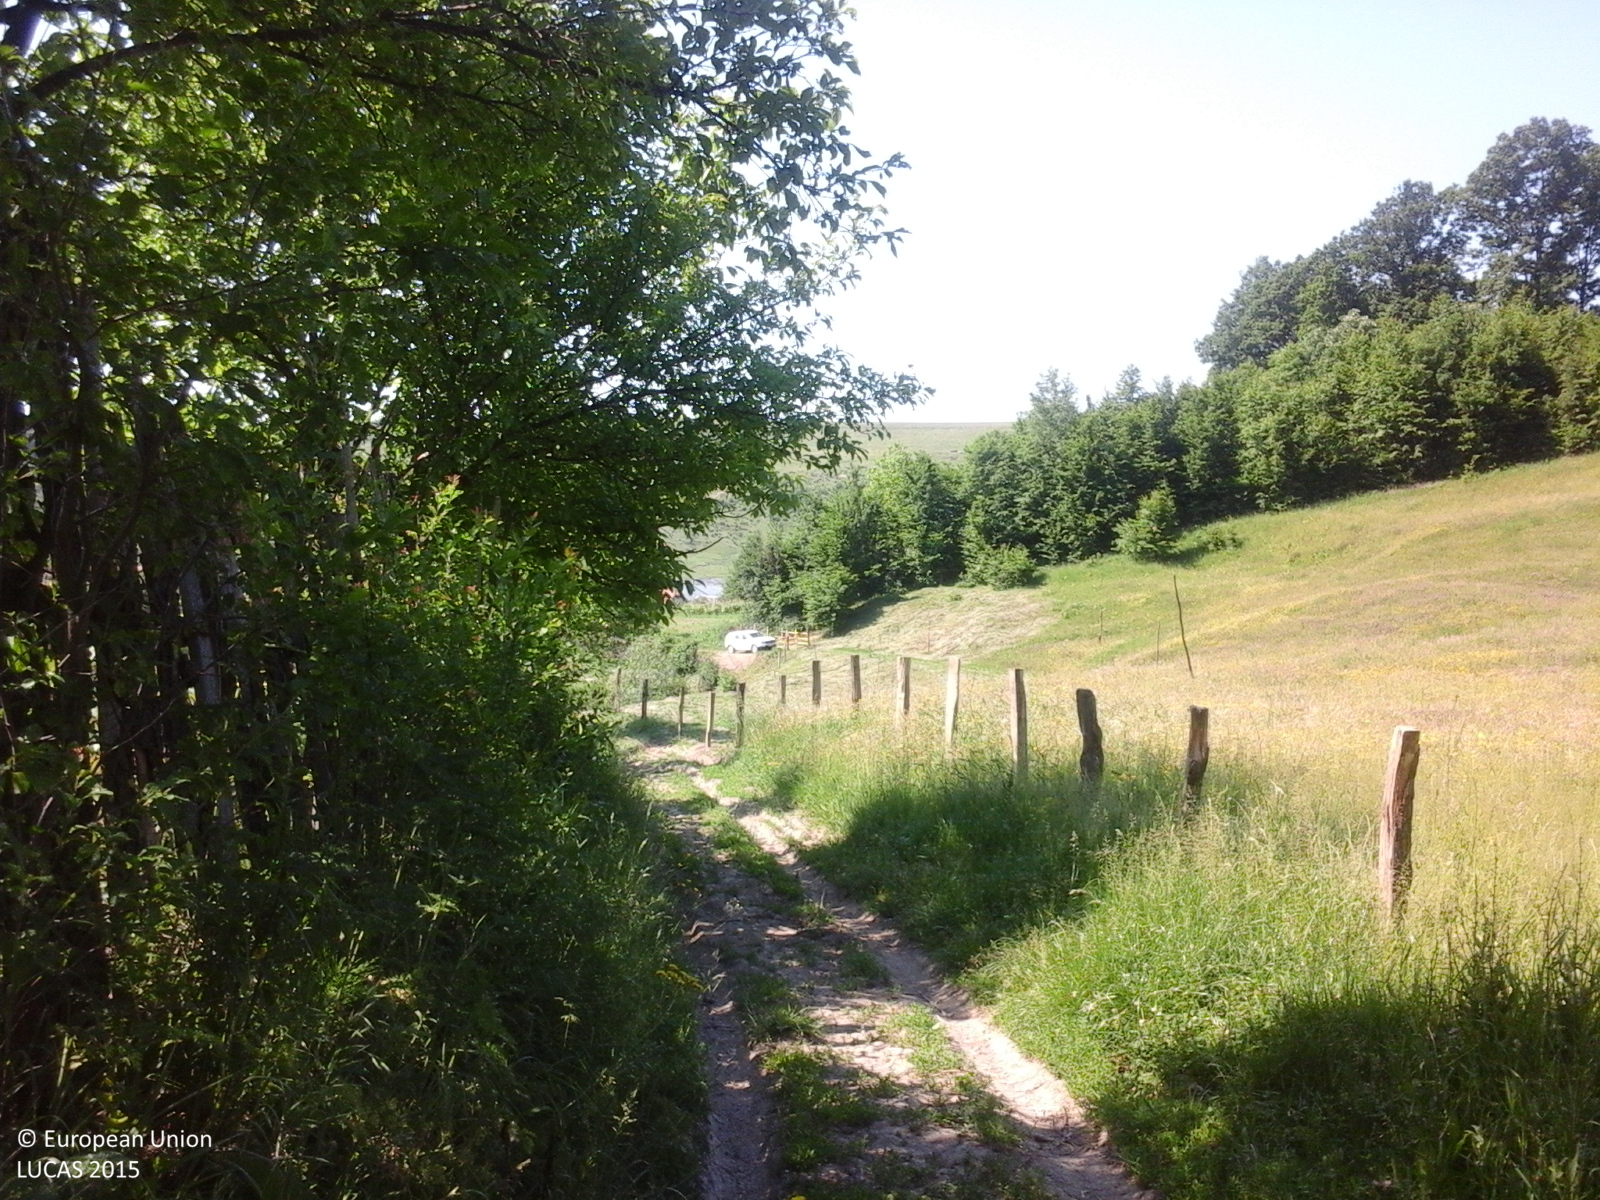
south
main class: Cropland
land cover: Vineyards
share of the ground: 50 - 75 %
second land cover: Grassland without tree/shrub cover
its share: 10 - 25 %
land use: Agriculture (excluding fallow land and kitchen gardens)
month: June
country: RO
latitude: 46.3741
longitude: 26.6608
